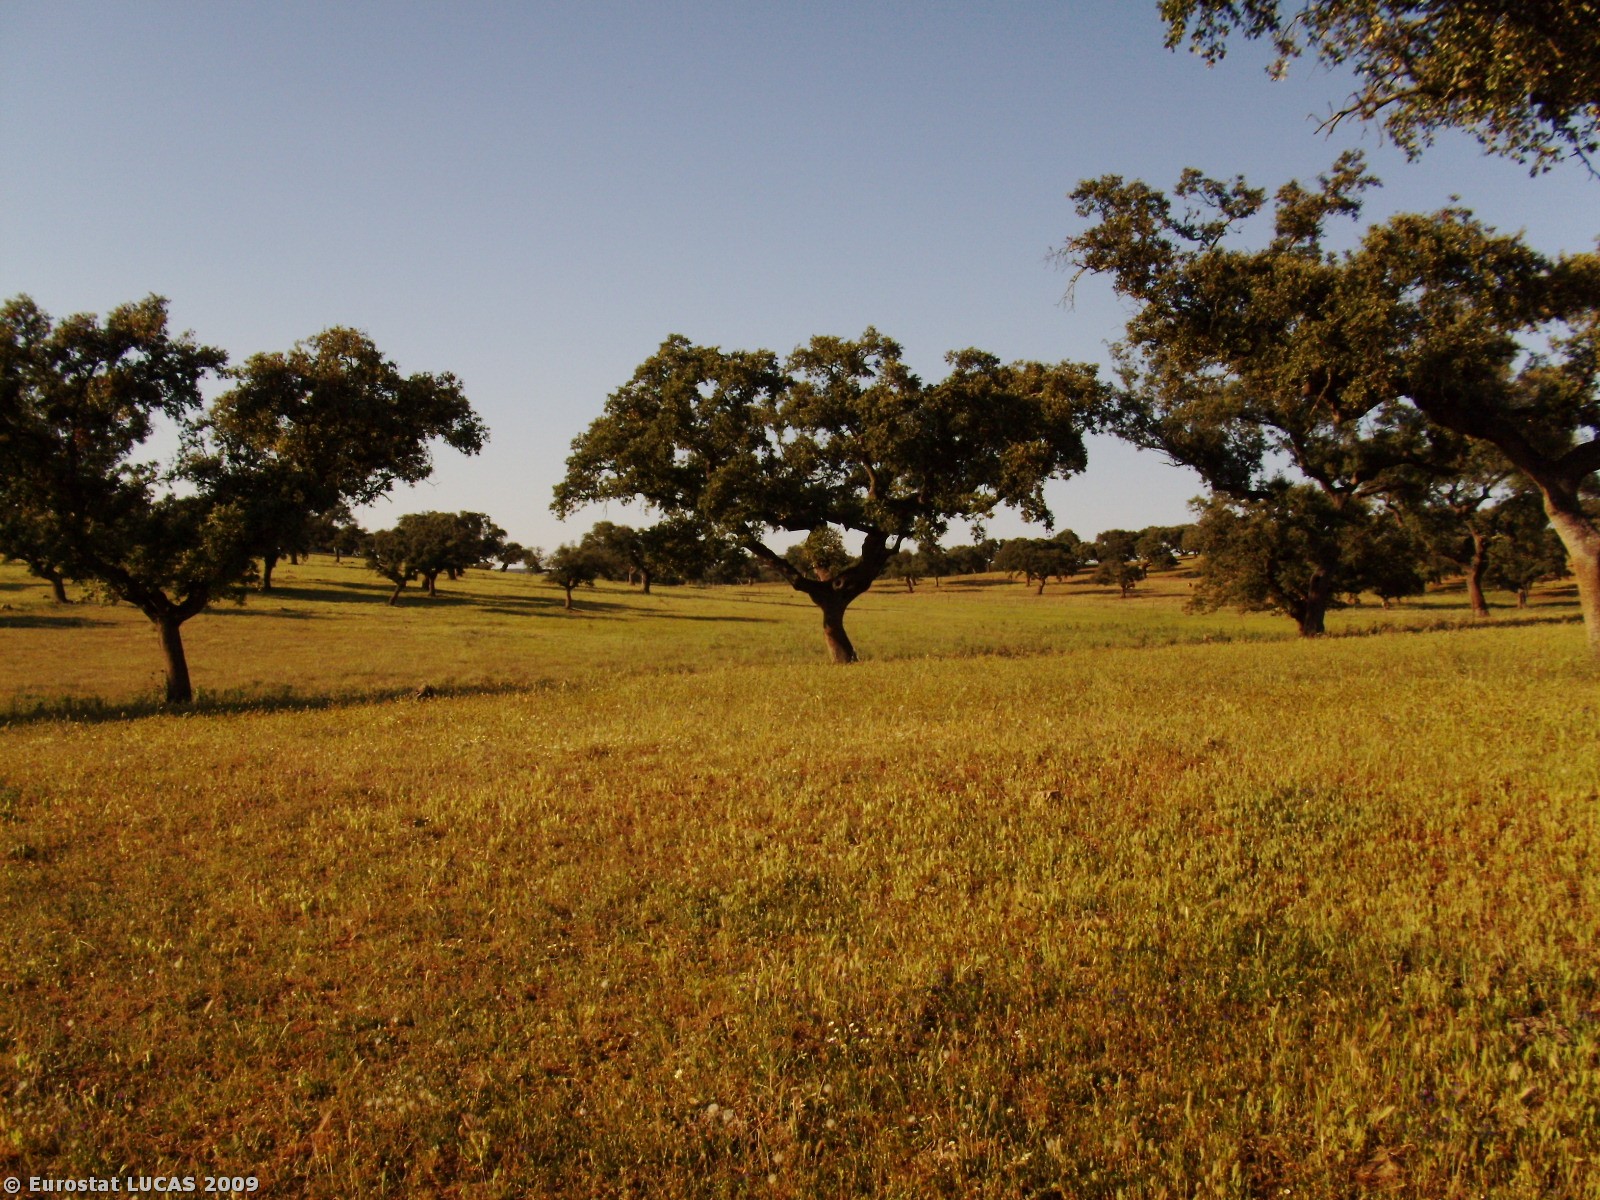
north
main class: Woodland
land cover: Broadleaved woodland
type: broadleaved evergreen forest
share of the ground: 10 - 25 %
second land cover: Spontaneously vegetated surfaces
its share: 25 - 50 %
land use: Agriculture (excluding fallow land and kitchen gardens)
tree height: > 5 m
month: May
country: PT
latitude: 38.7933
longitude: -7.2875
